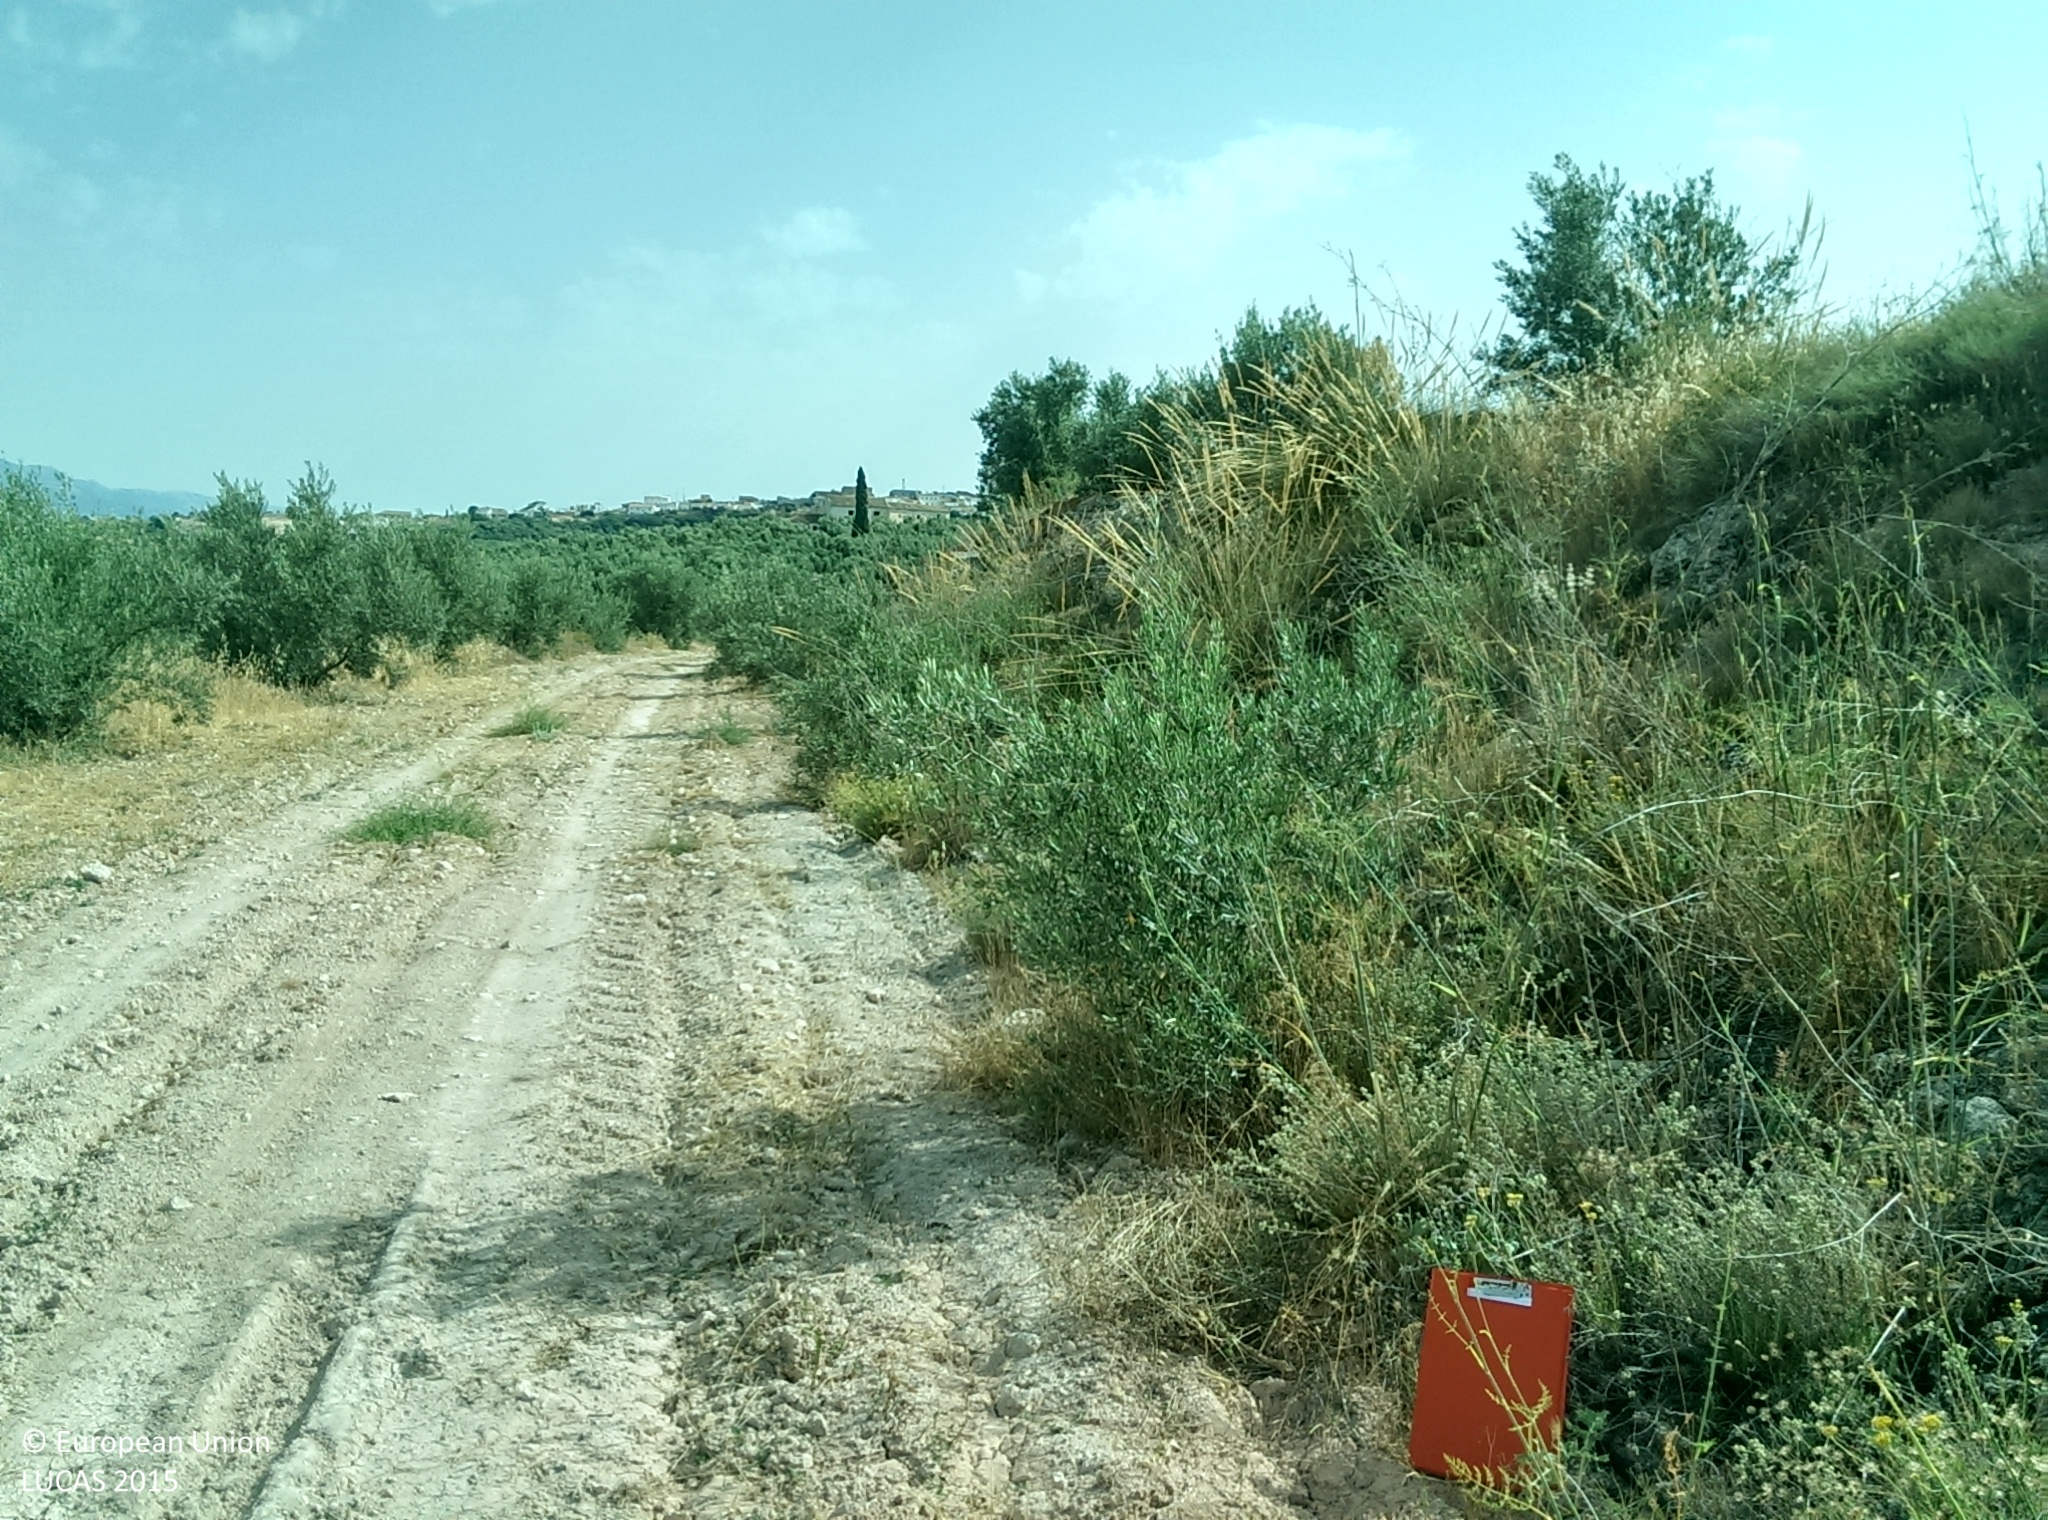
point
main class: Cropland
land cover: Olive groves
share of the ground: 10 - 25 %
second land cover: Spontaneously vegetated surfaces
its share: 50 - 75 %
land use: Agriculture (excluding fallow land and kitchen gardens)
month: July
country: ES
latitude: 37.5937
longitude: -2.9351
